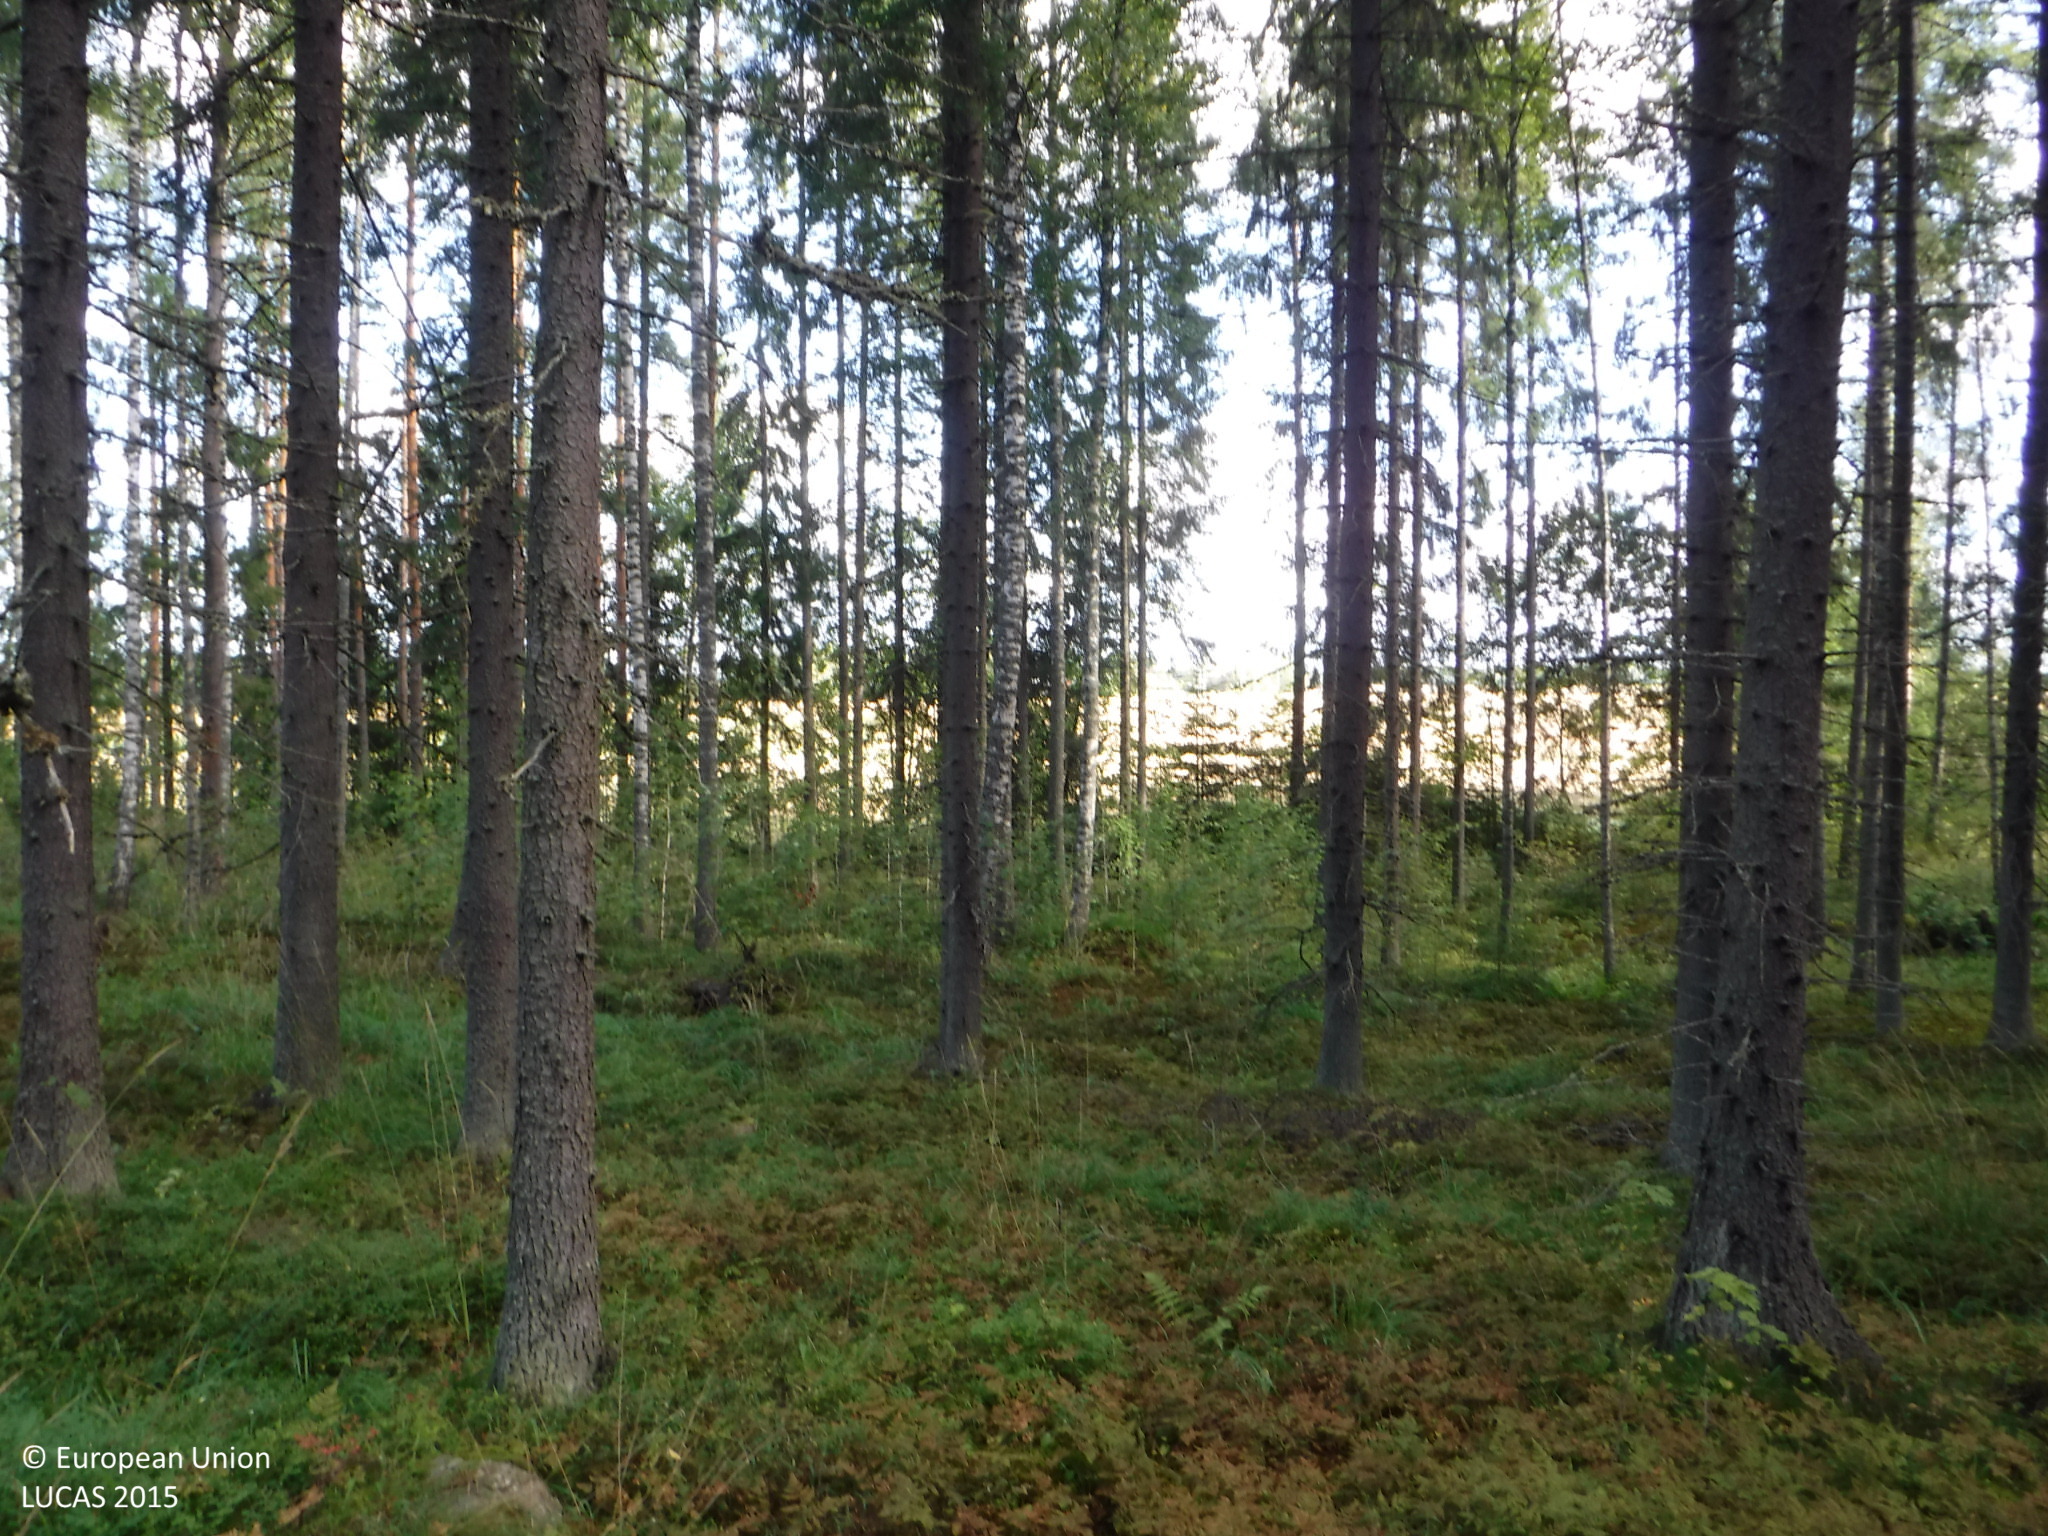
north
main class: Woodland
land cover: Spruce dominated coniferous woodland
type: boreal forest
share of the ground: 50 - 75 %
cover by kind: coniferous forest trees 70 %, shrubs 15 %, herbaceous plants 10 %, lichens and mosses 5 %
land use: Forestry
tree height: > 5 m
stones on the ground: < 10 %
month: August
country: FI
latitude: 61.3064
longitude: 22.0263
